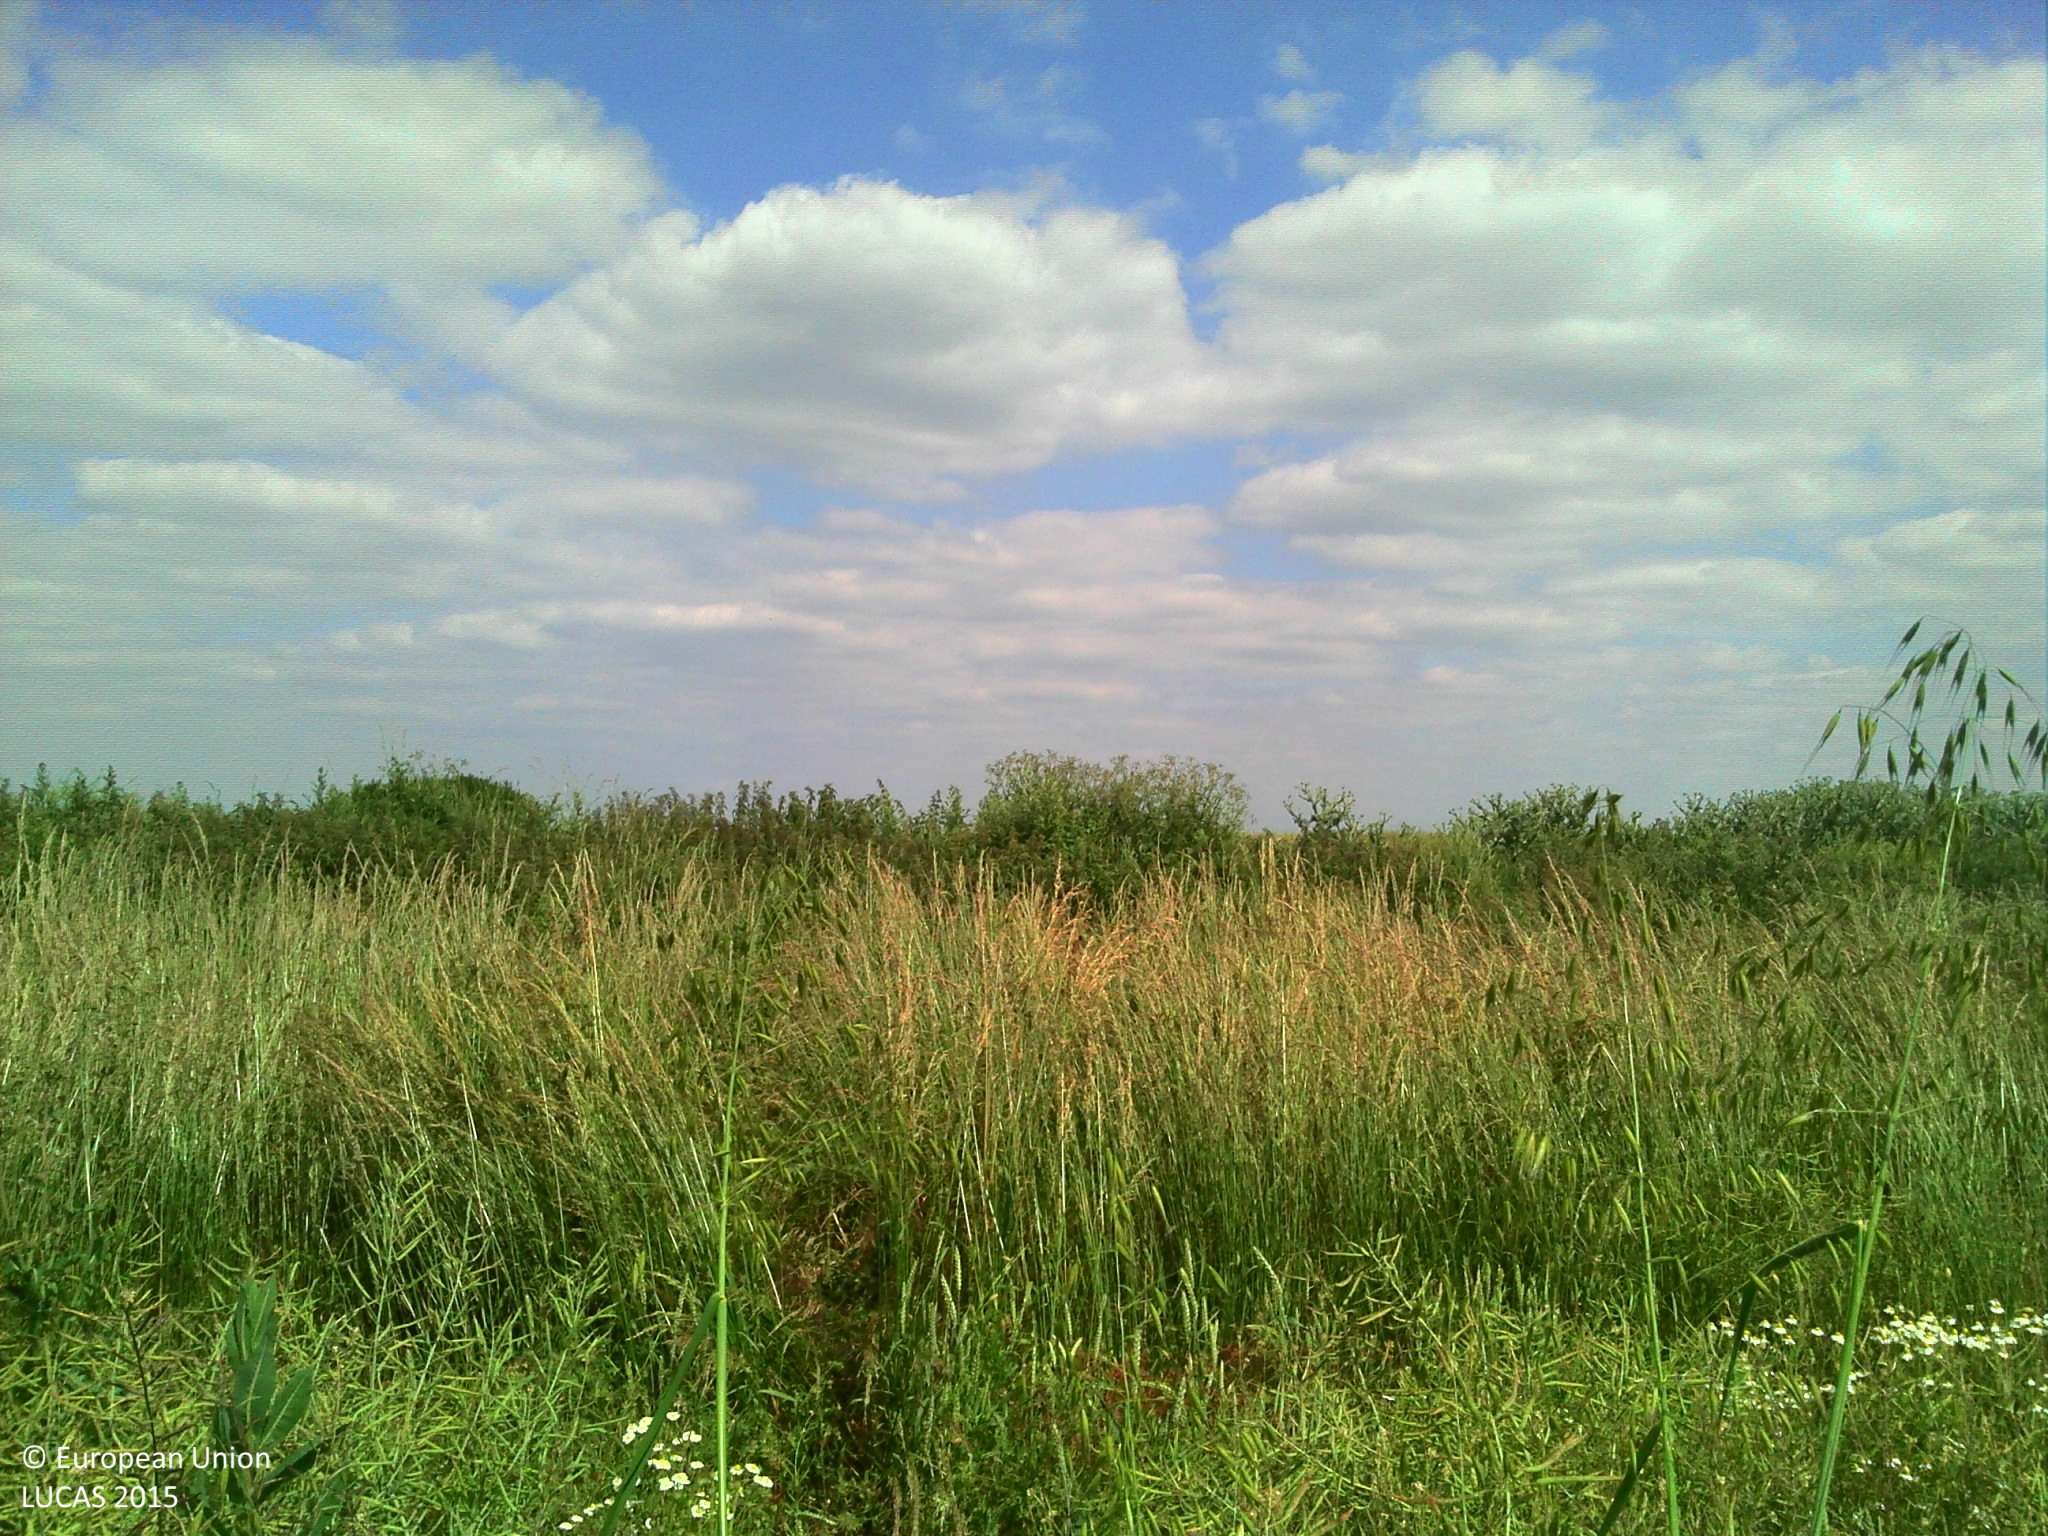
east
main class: Cropland
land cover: Rape and turnip rape
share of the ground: > 75 %
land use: Agriculture (excluding fallow land and kitchen gardens)
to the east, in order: Rape and turnip rape; Spontaneously vegetated surfaces; Grass margins; Paved roads, cycling and walking lanes; Grass margins; Rape and turnip rape; Maize; Grassland without tree/shrub cover; Maize; Common wheat
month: June
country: FR
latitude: 49.6496
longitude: 2.8011
